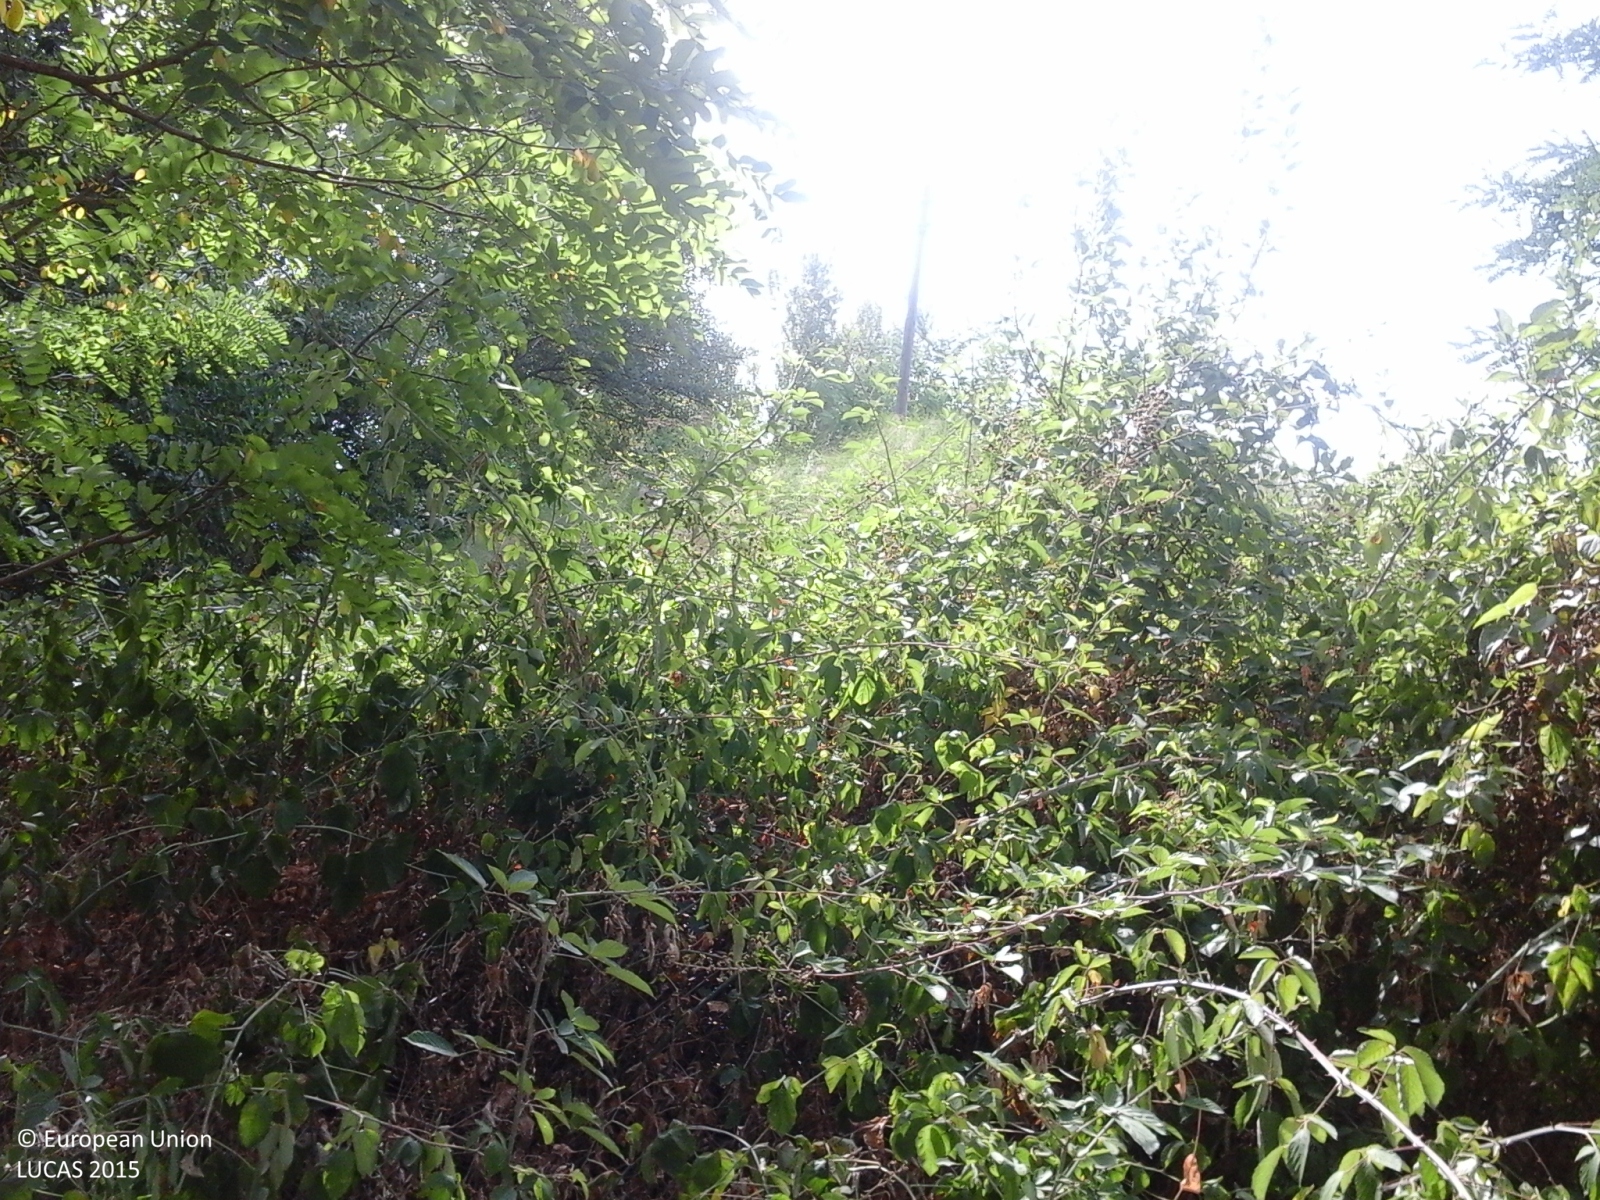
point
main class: Shrubland
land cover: Shrubland with sparse tree cover
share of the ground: > 75 %
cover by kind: shrubs 70 %, herbaceous plants 25 %, broadleaved forest trees 5 %
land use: Semi-natural and natural areas not in use
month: August
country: IT
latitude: 43.8210
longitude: 12.2449
